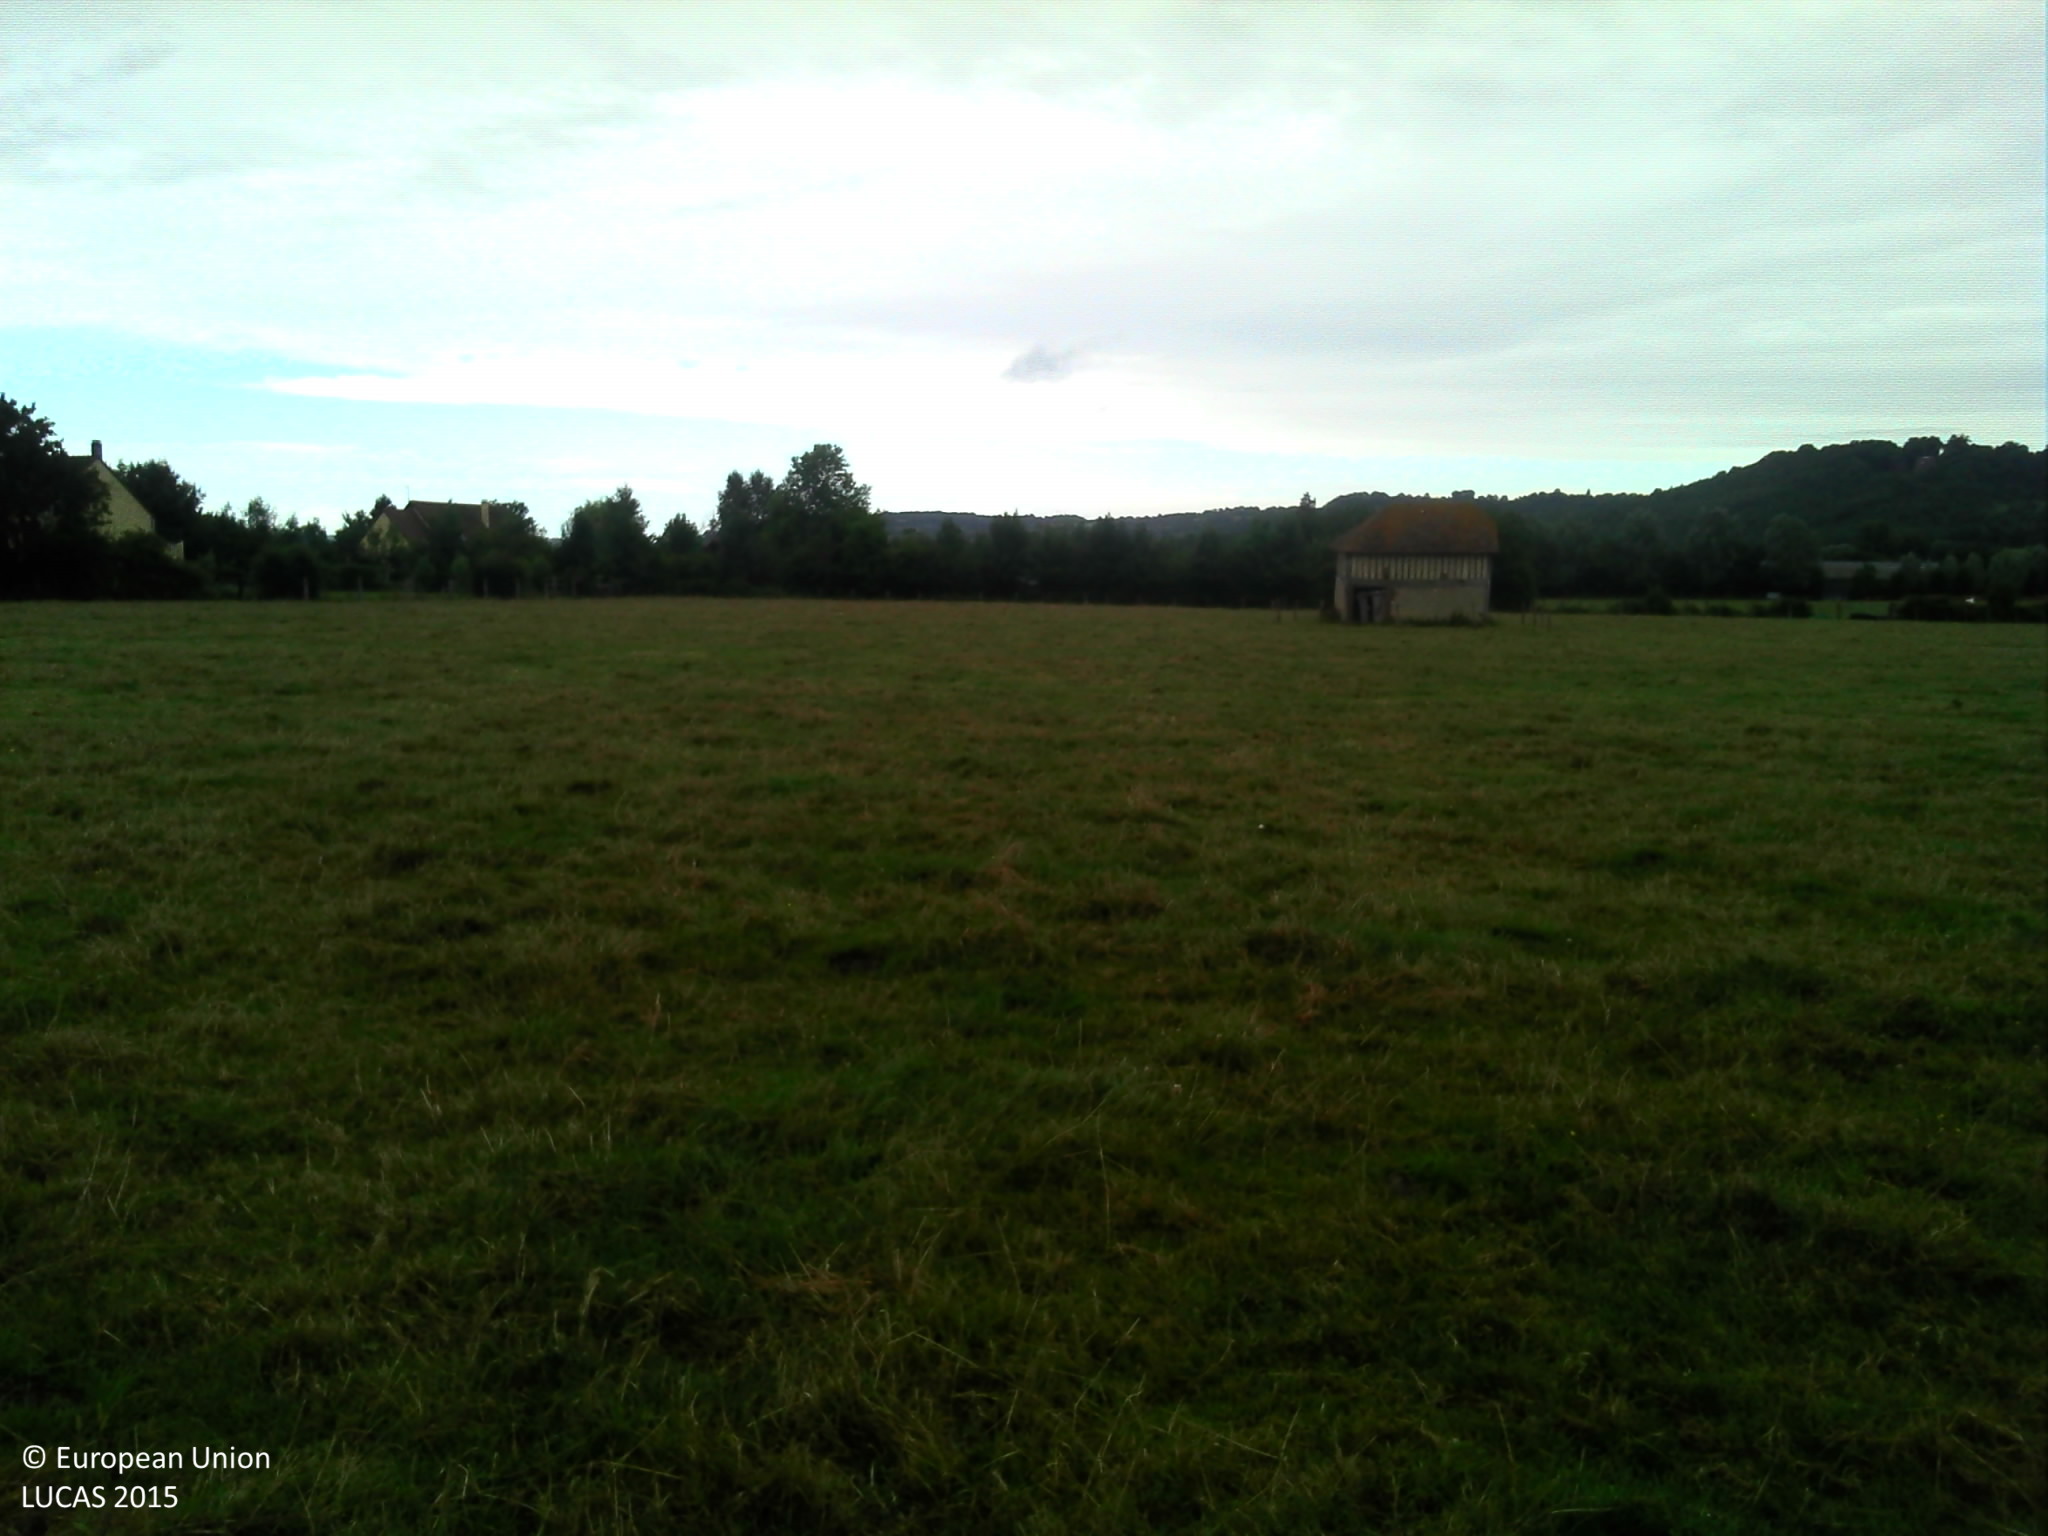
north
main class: Grassland
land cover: Grassland without tree/shrub cover
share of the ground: > 75 %
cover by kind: herbaceous plants 100 %
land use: Agriculture (excluding fallow land and kitchen gardens)
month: July
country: FR
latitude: 49.1101
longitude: 0.0099
